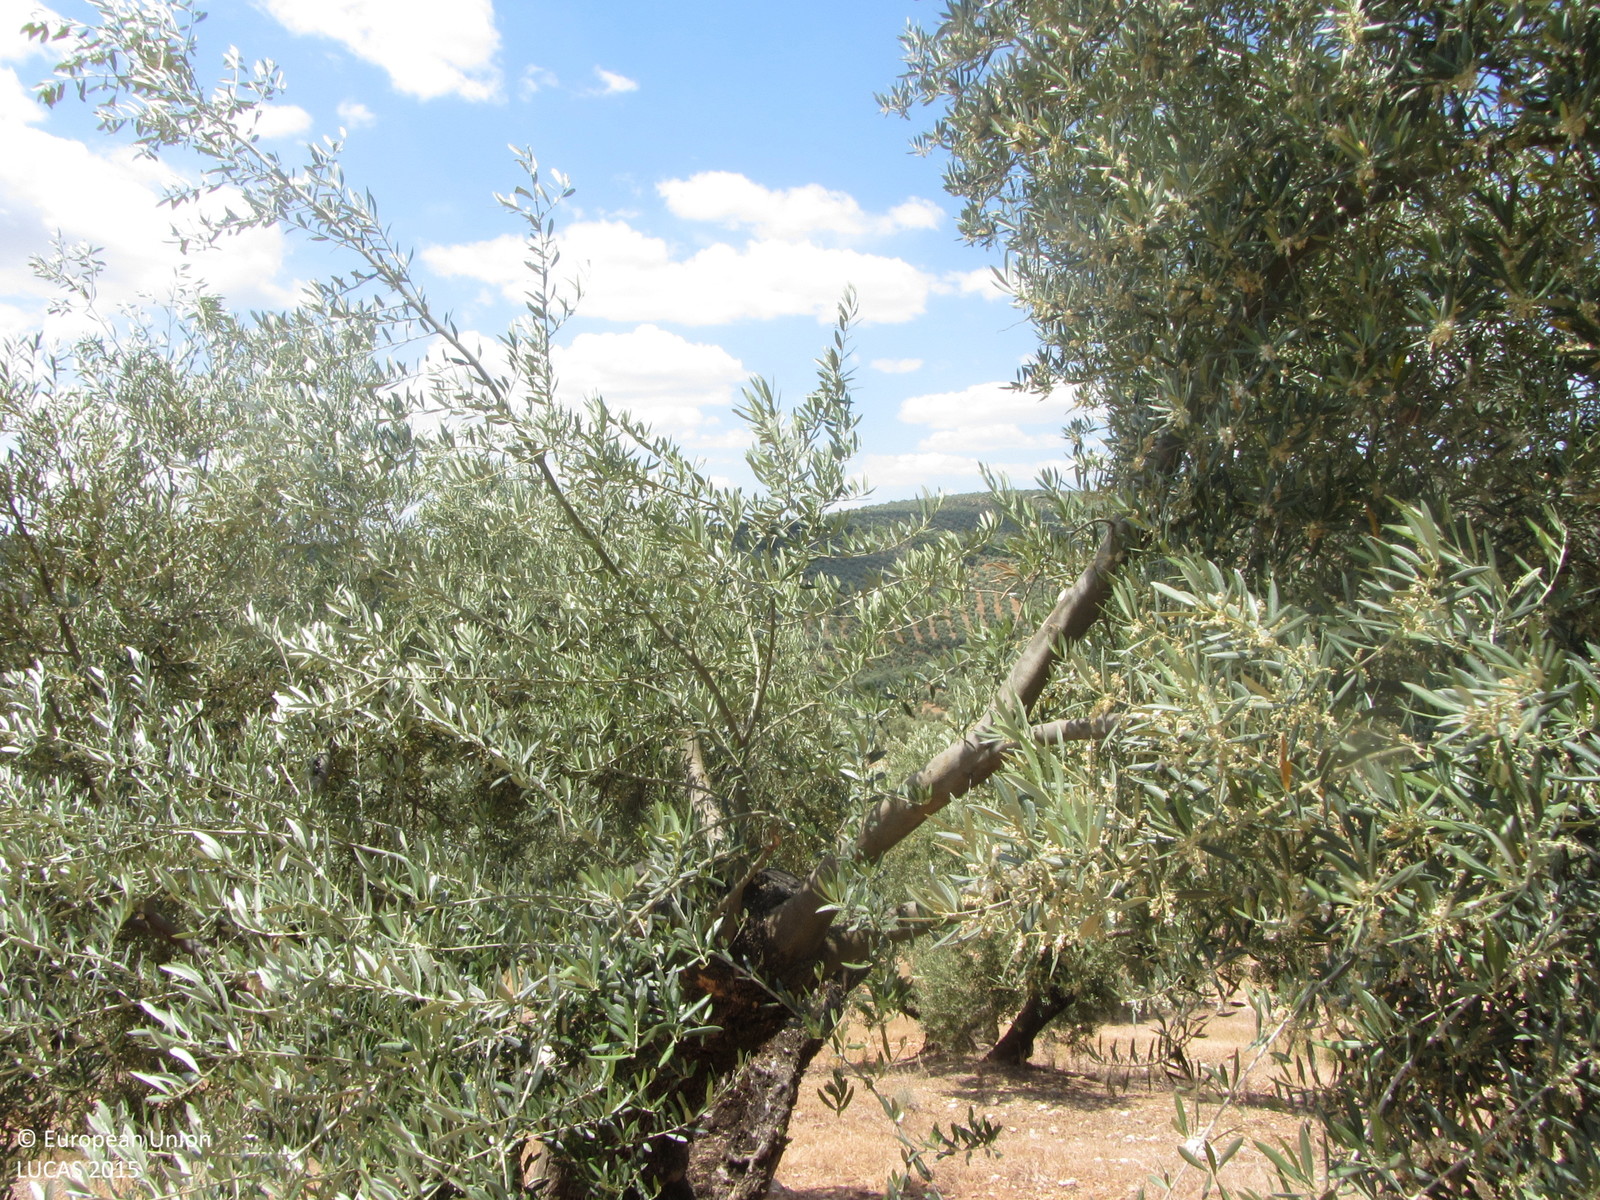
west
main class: Cropland
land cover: Olive groves
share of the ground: 50 - 75 %
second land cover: Spontaneously vegetated surfaces
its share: > 75 %
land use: Agriculture (excluding fallow land and kitchen gardens)
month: May
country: ES
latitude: 38.1875
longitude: -3.2798
